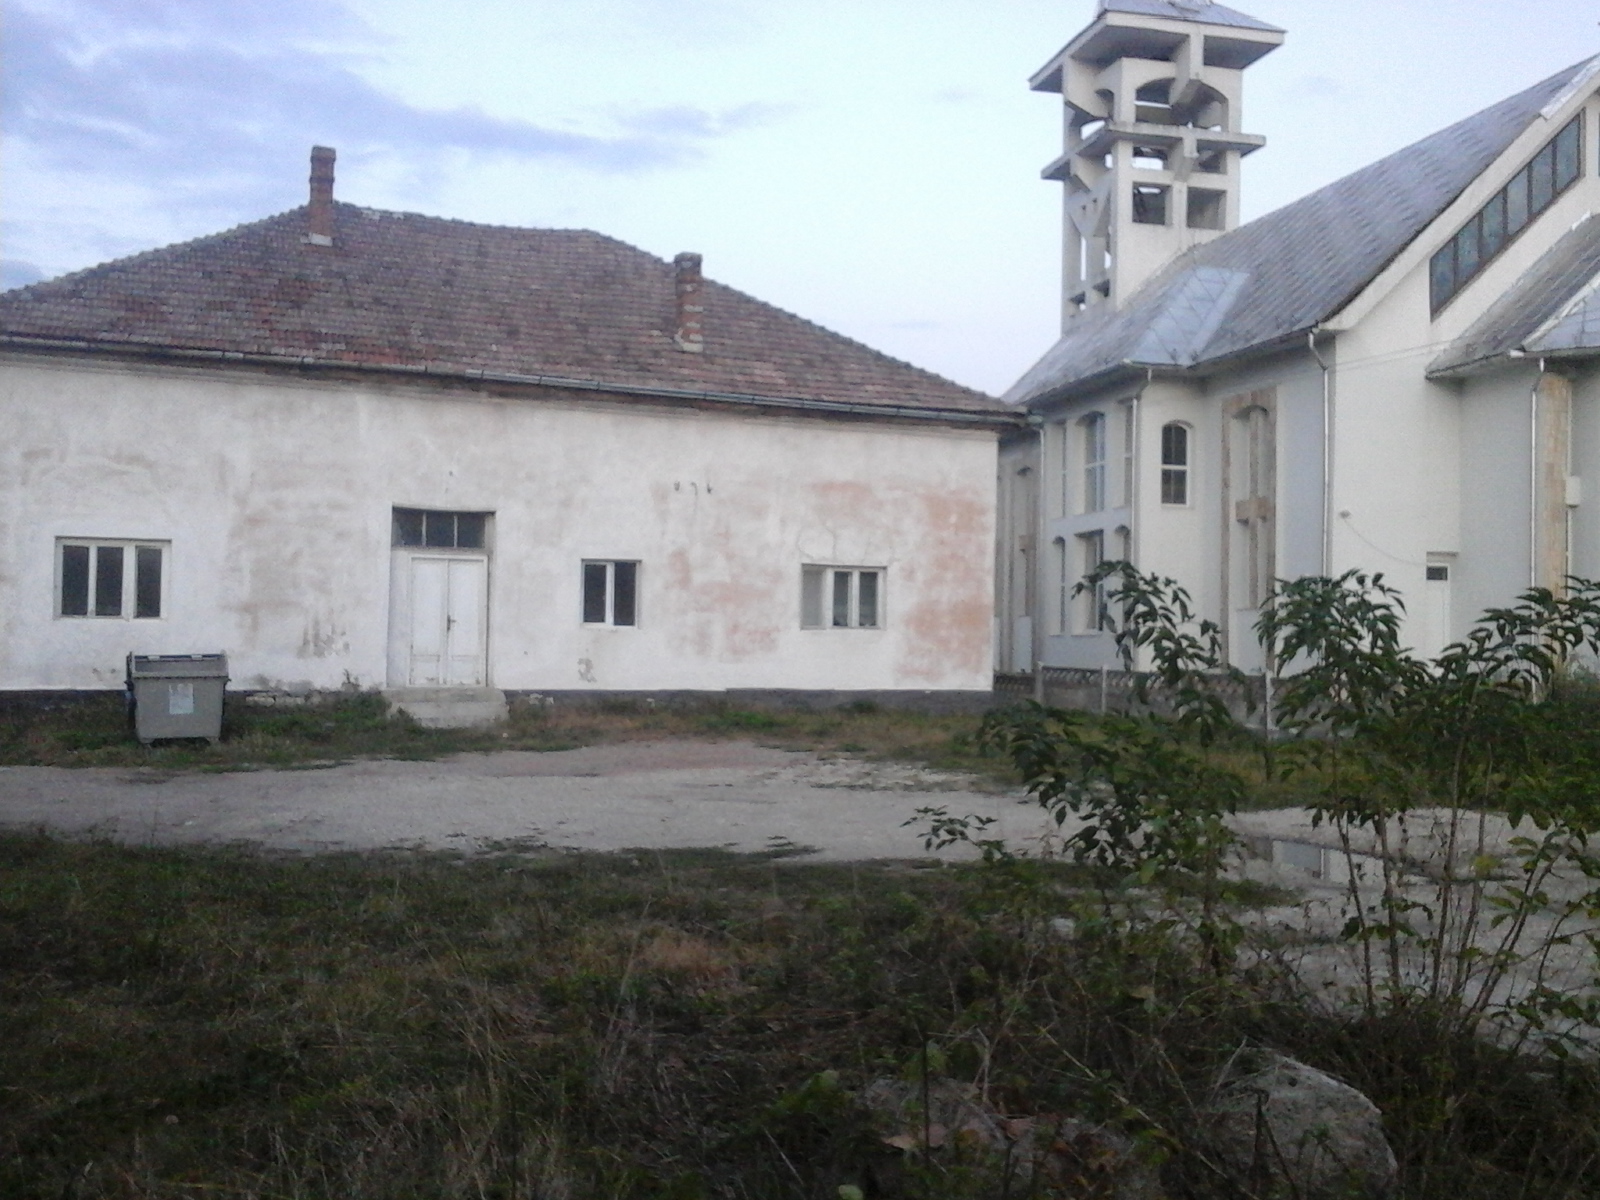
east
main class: Cropland
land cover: Other fruit trees and berries
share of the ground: > 75 %
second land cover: Grassland without tree/shrub cover
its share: > 75 %
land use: Agriculture (excluding fallow land and kitchen gardens)
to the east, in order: Other fruit trees and berries; Grassland without tree/shrub cover; Artificial constructions in urban areas; Permanent crops (only in case pi); Grassland without tree/shrub cover; Single bushes/trees; Abandoned hedges
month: September
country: RO
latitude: 47.5018
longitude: 23.4684
